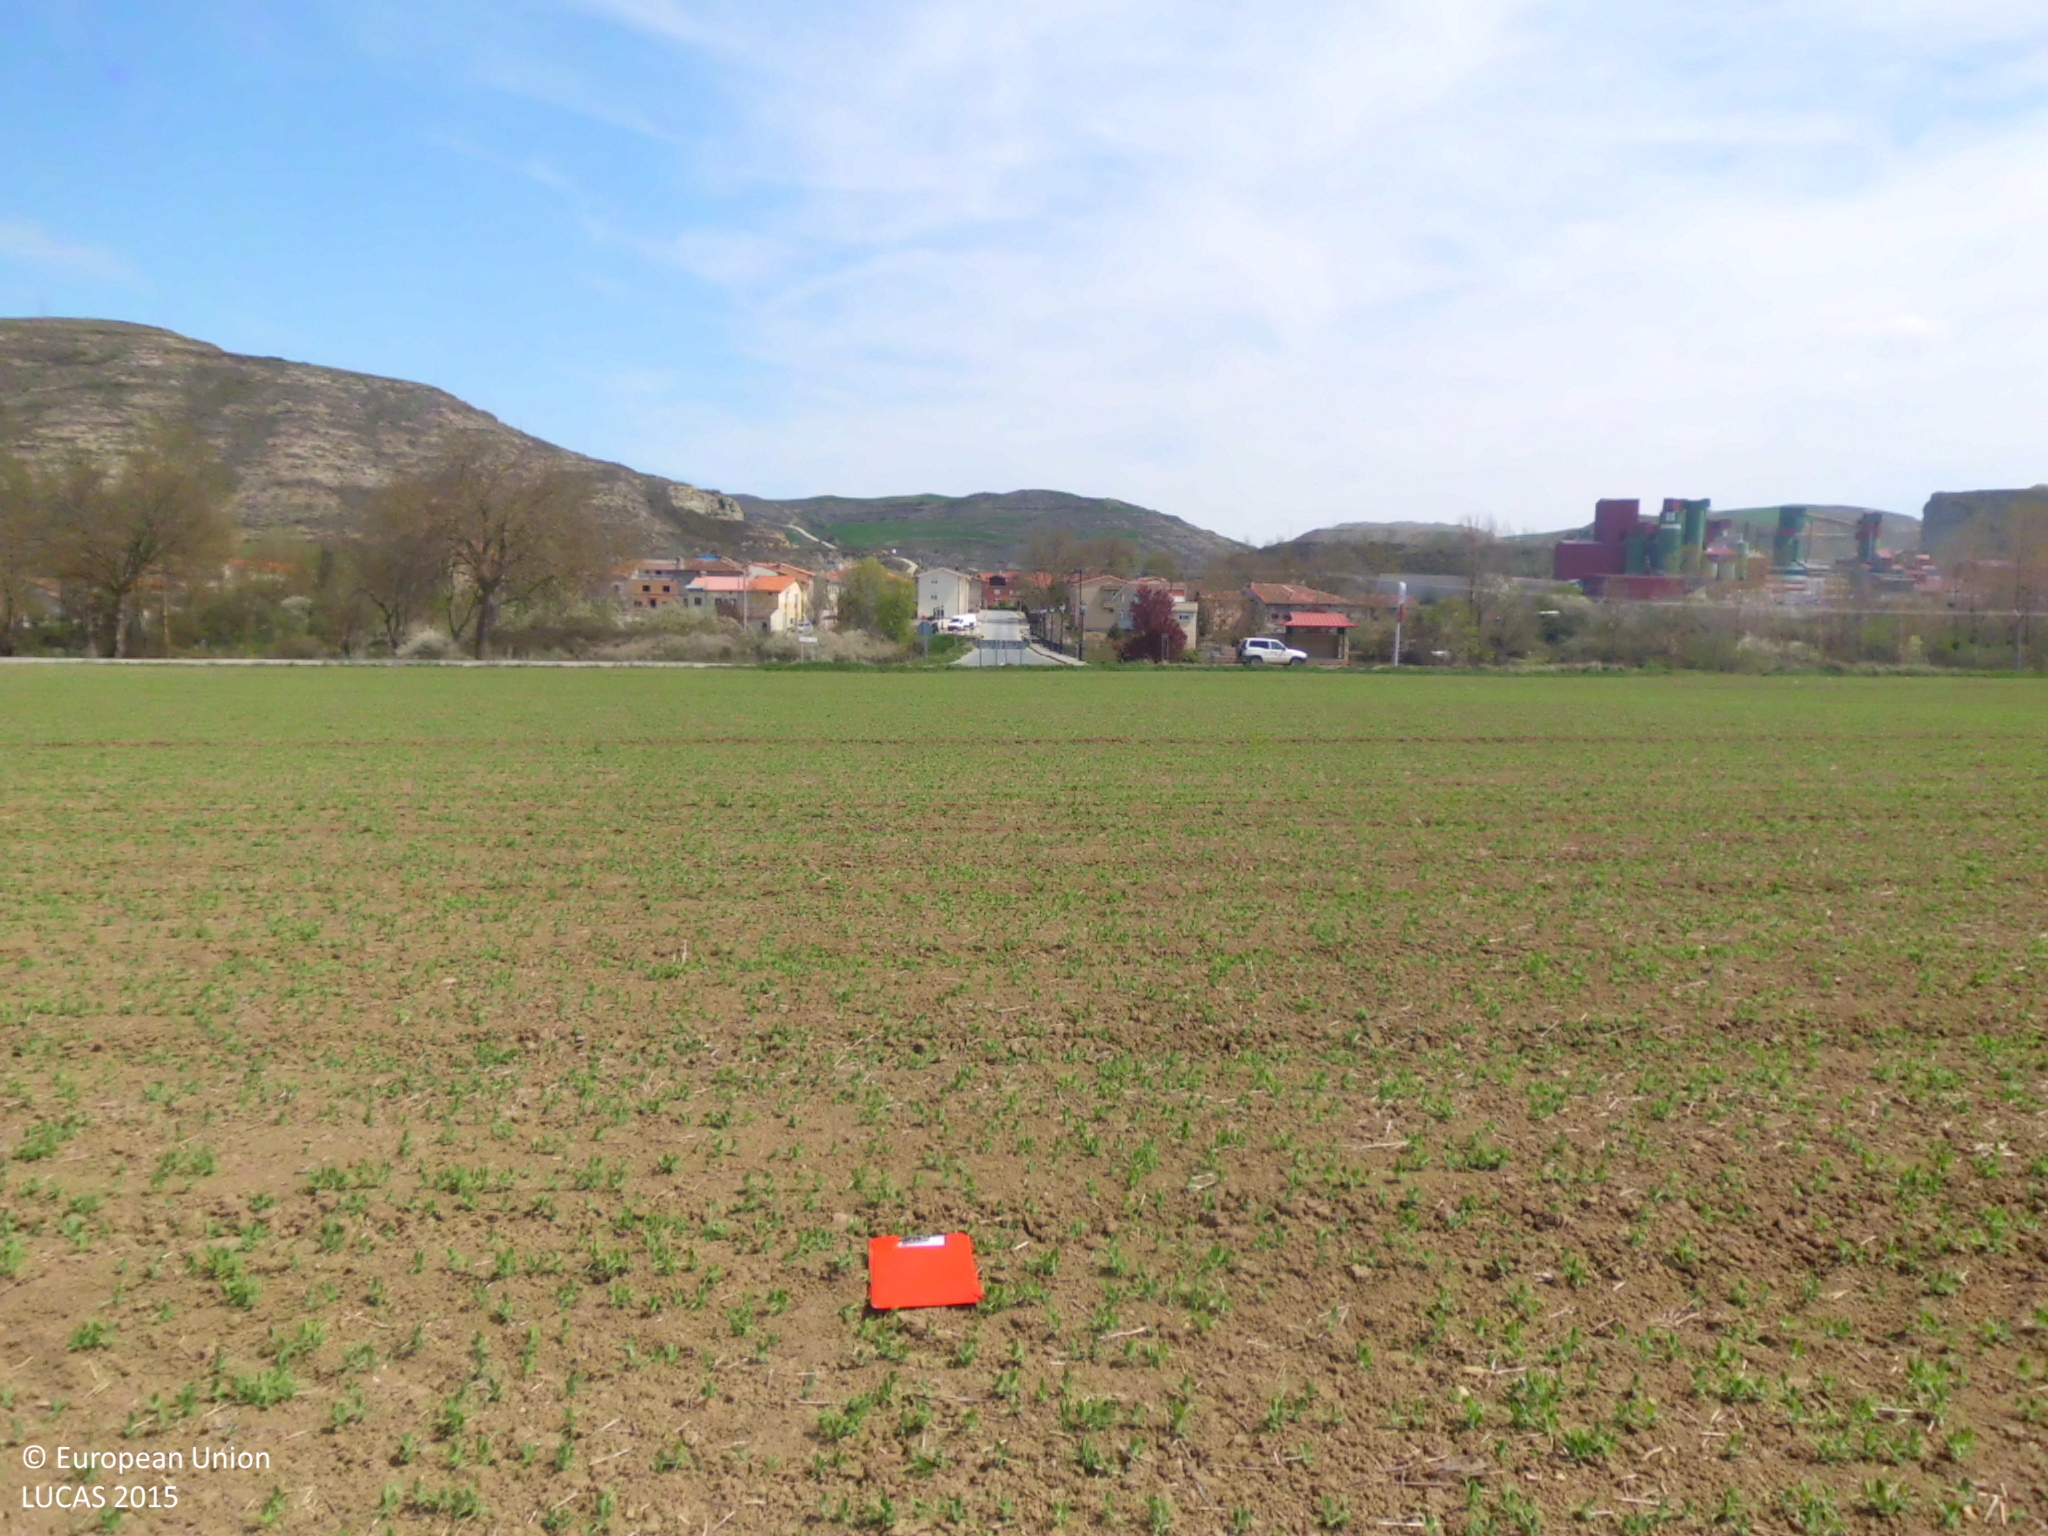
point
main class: Cropland
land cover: Dry pulses
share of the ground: < 10 %
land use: Agriculture (excluding fallow land and kitchen gardens)
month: April
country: ES
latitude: 42.4284
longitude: -3.3165
